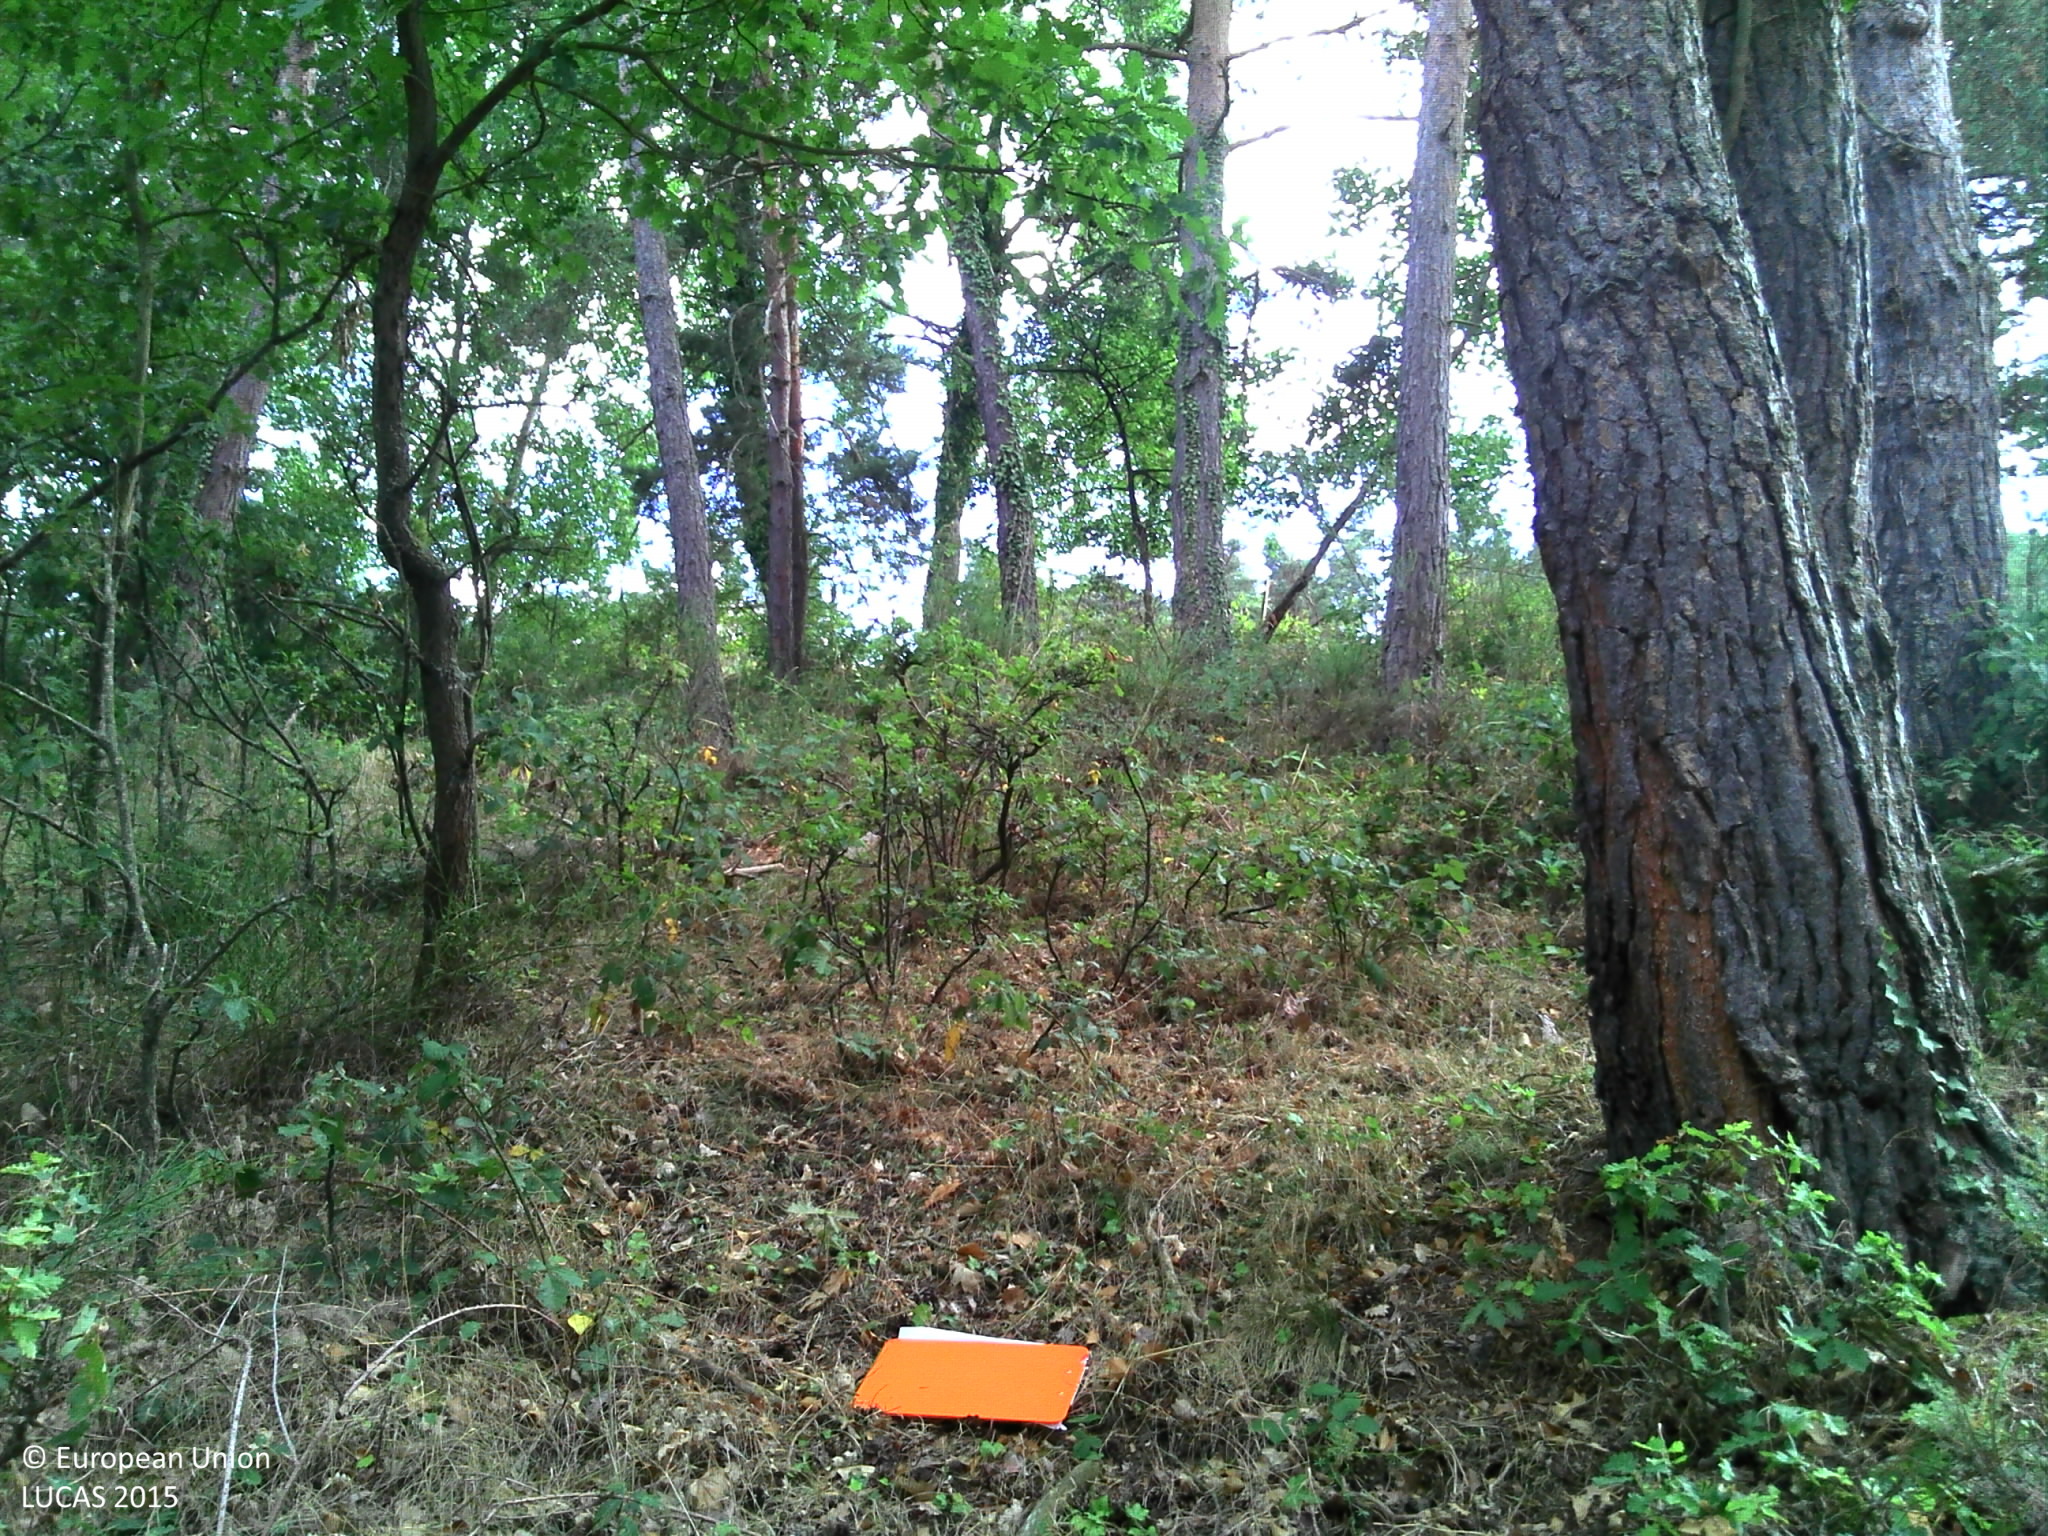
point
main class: Woodland
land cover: Pine dominated mixed woodland
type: hemiboreal forest and nemoral coniferous forest and mixed broadleaved-coniferous forest
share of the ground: > 75 %
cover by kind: broadleaved forest trees 55 %, coniferous forest trees 25 %, shrubs 10 %, herbaceous plants 10 %
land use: Agriculture (excluding fallow land and kitchen gardens)
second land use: Forestry
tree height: > 5 m
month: July
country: FR
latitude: 45.1385
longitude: 3.4539
